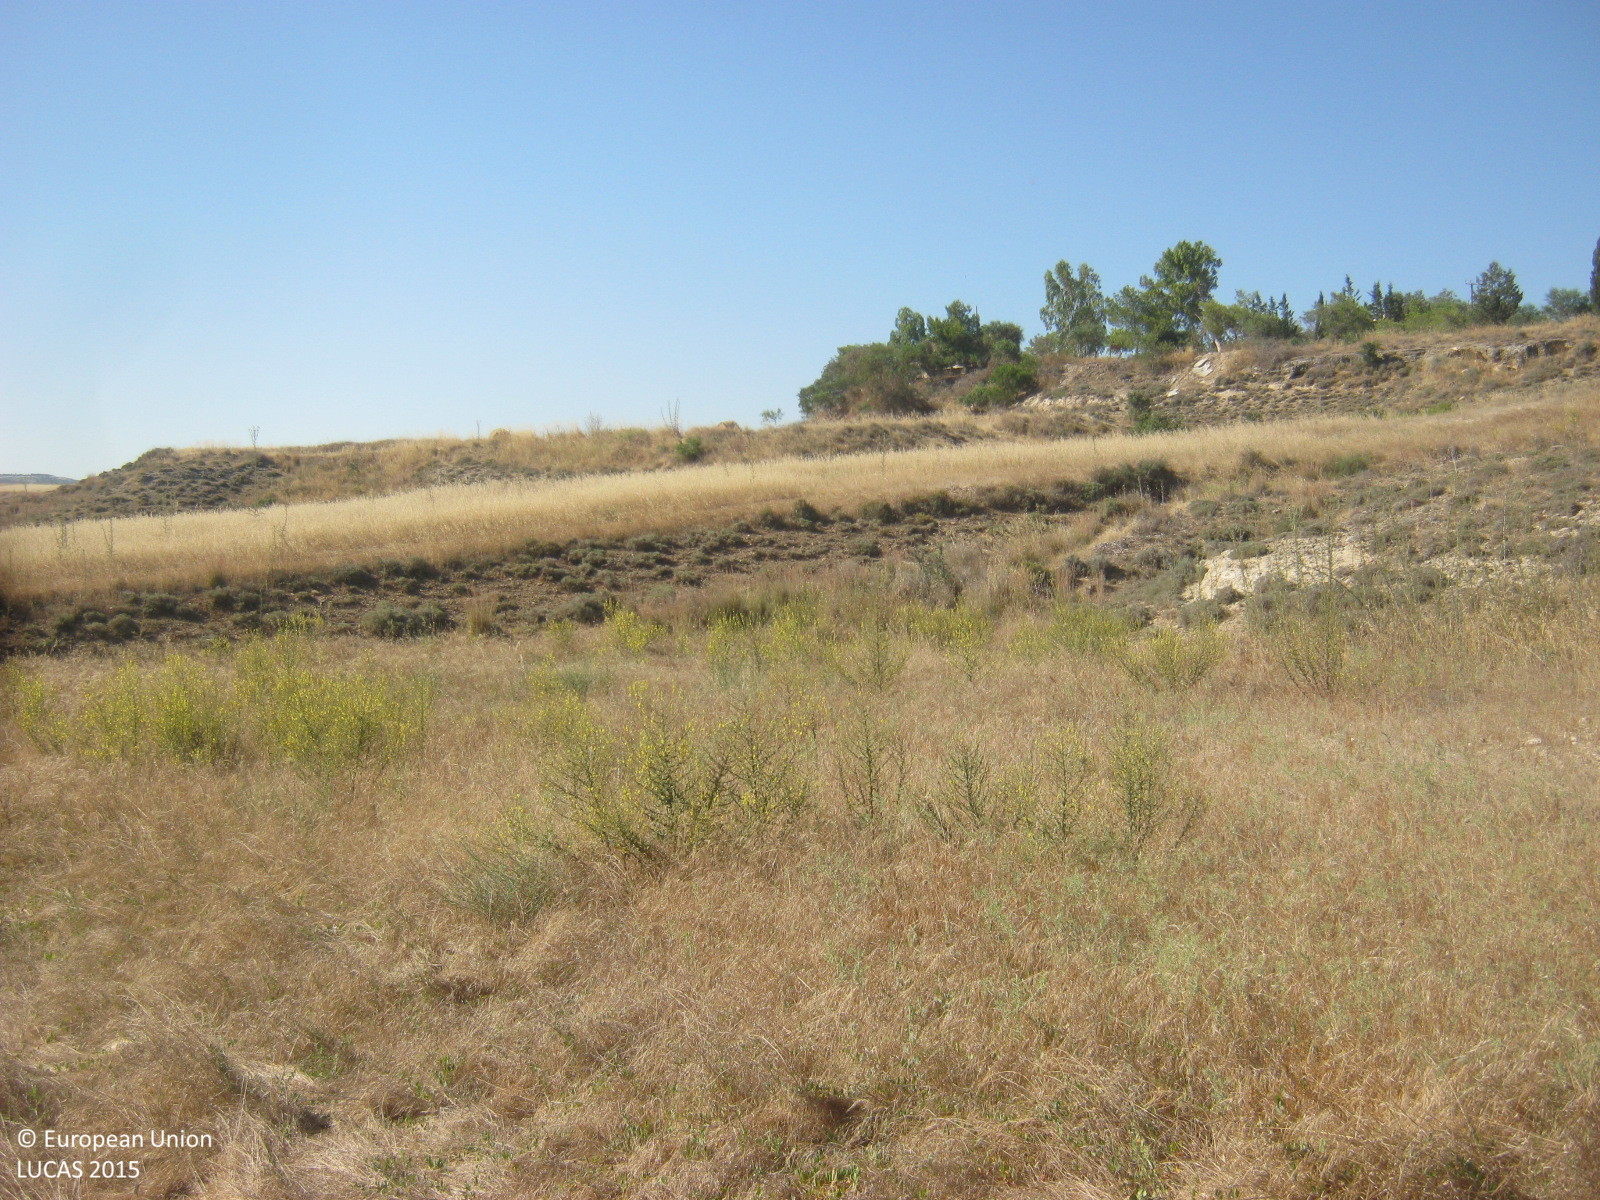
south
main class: Shrubland
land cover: Shrubland without tree cover
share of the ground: 10 - 25 %
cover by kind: herbaceous plants 70 %, shrubs 15 %, unconsolidated bare surface 15 %
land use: Semi-natural and natural areas not in use
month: June
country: CY
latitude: 35.1071
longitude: 33.1685
